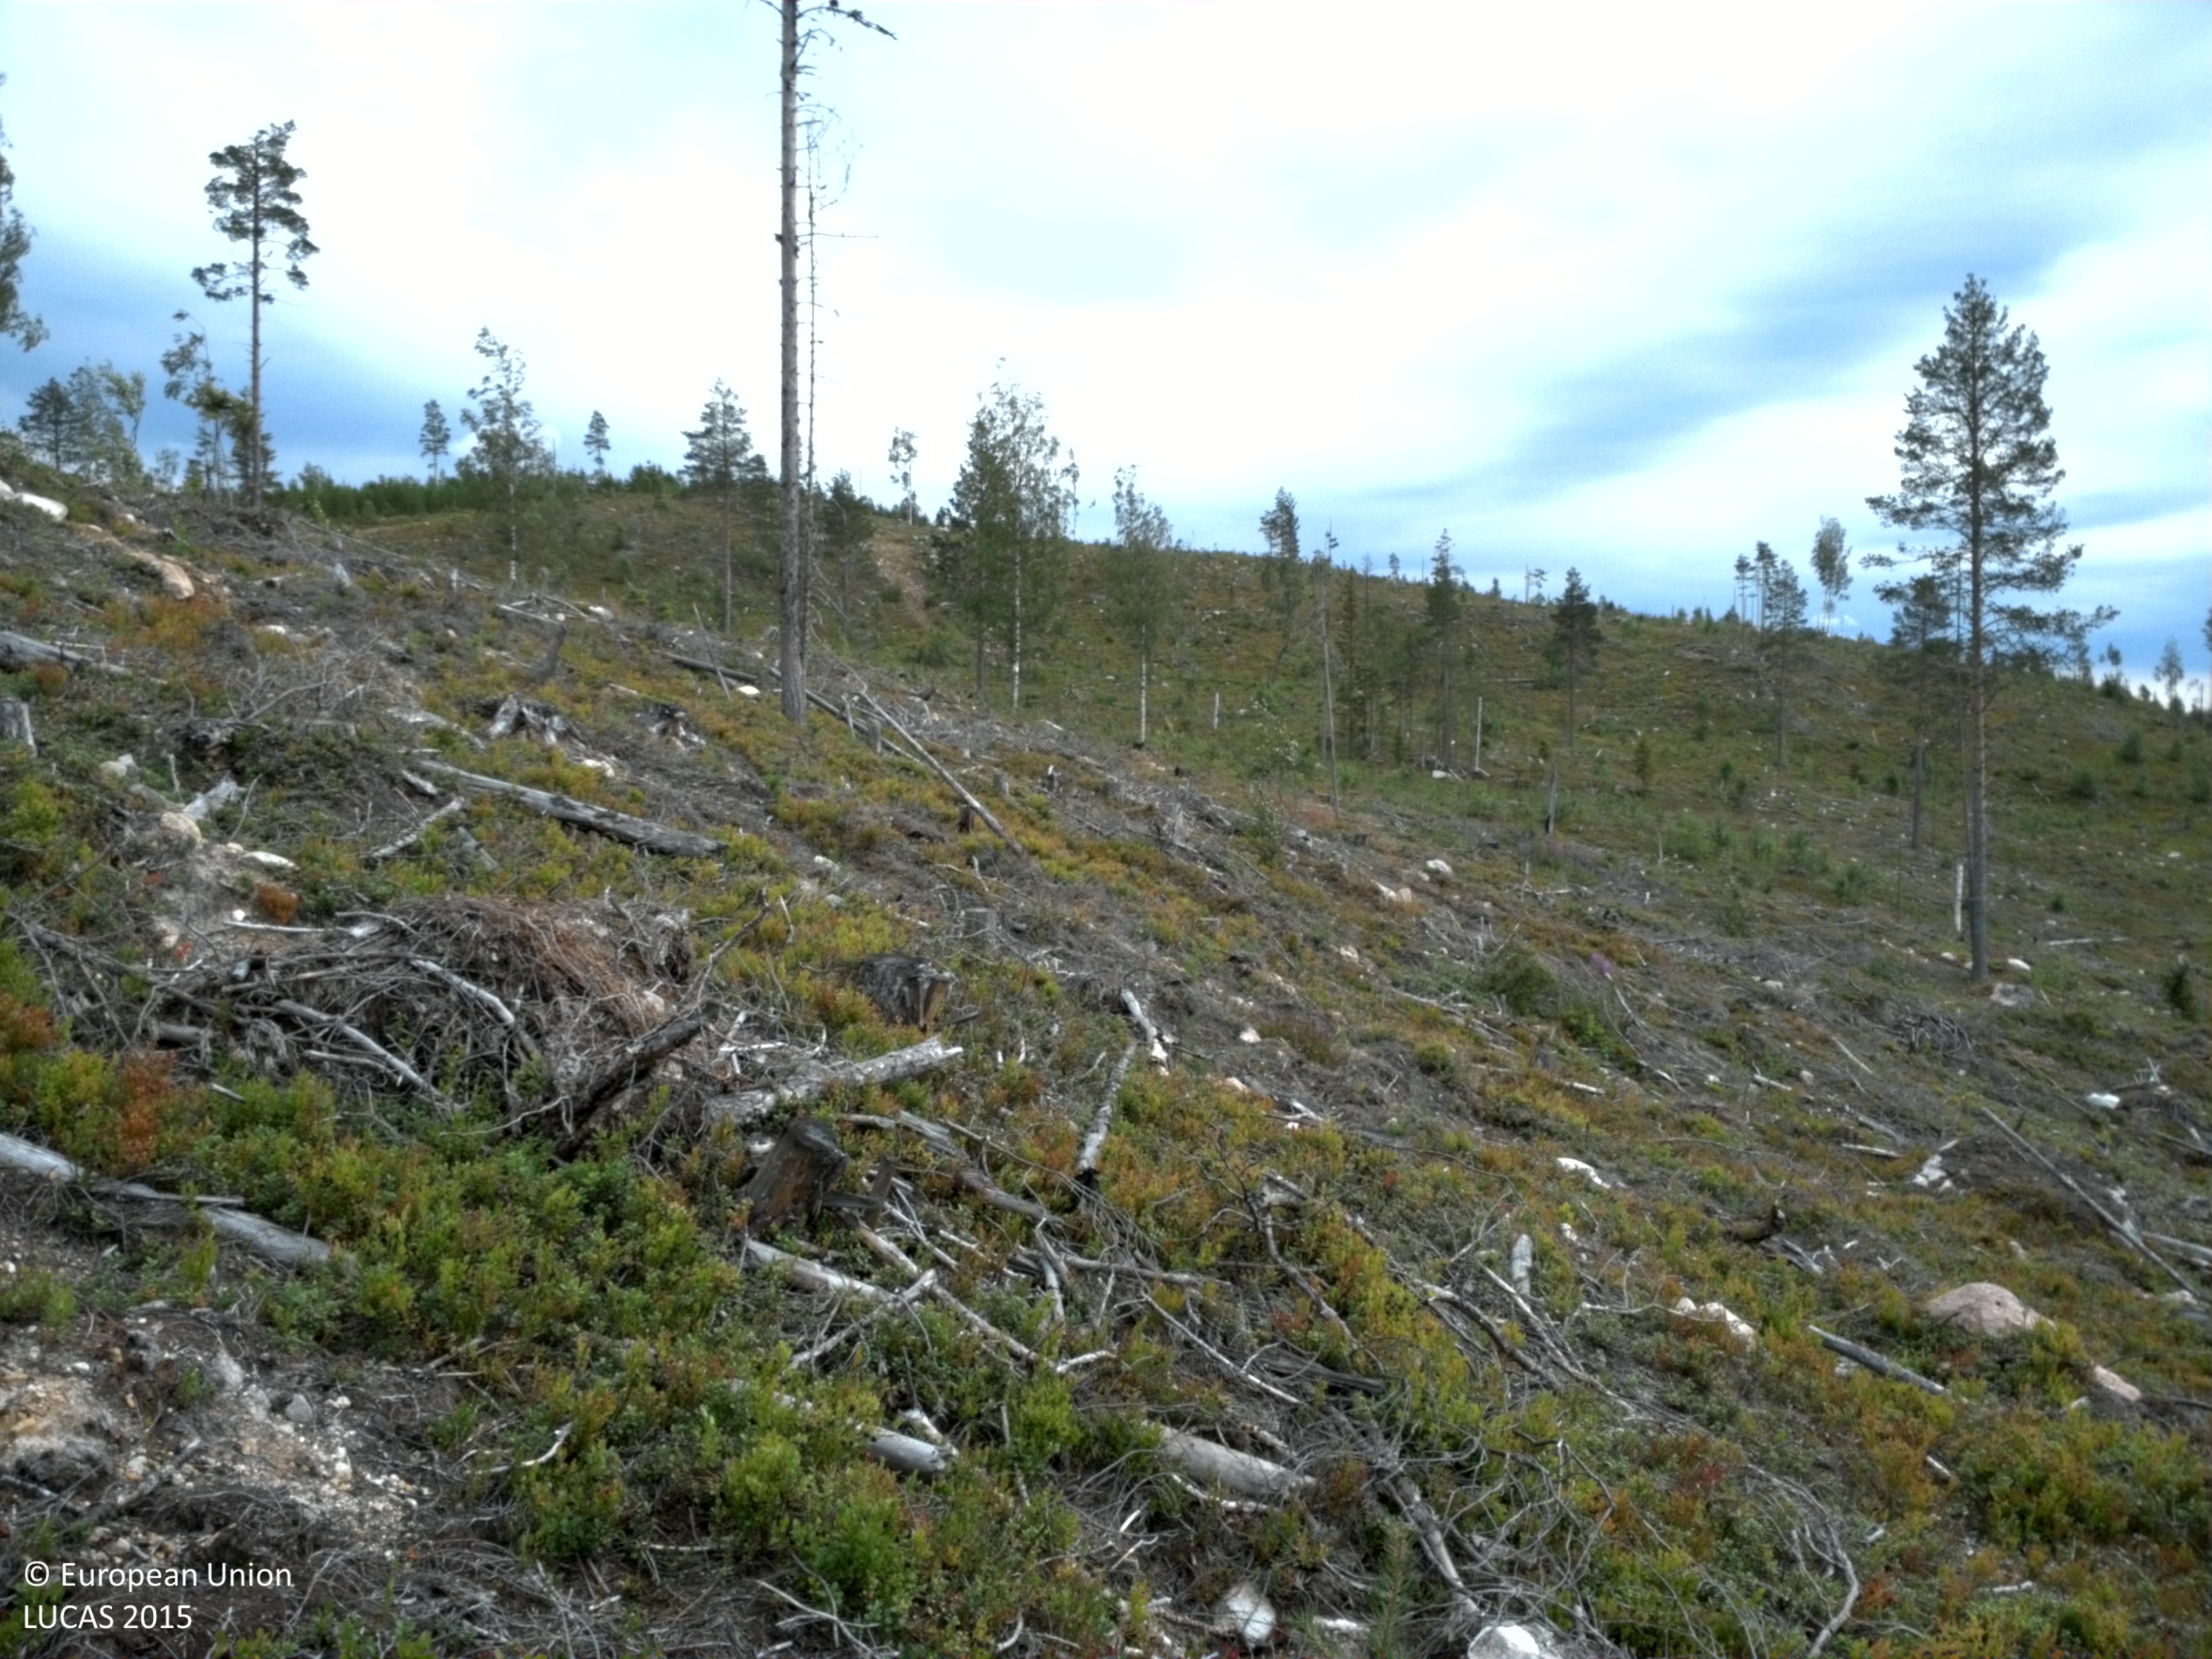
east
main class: Shrubland
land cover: Shrubland with sparse tree cover
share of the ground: > 75 %
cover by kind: shrubs 80 %, broadleaved forest trees 5 %, lichens and mosses 5 %, consolidated bare surface 5 %, unconsolidated bare surface 5 %
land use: Forestry
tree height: < 5 m
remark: Clear cut
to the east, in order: Shrubland with sparse tree cover; Tracks; Shrubland with sparse tree cover; Tracks; Shrubland with sparse tree cover
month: August
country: SE
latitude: 66.3137
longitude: 20.5098
